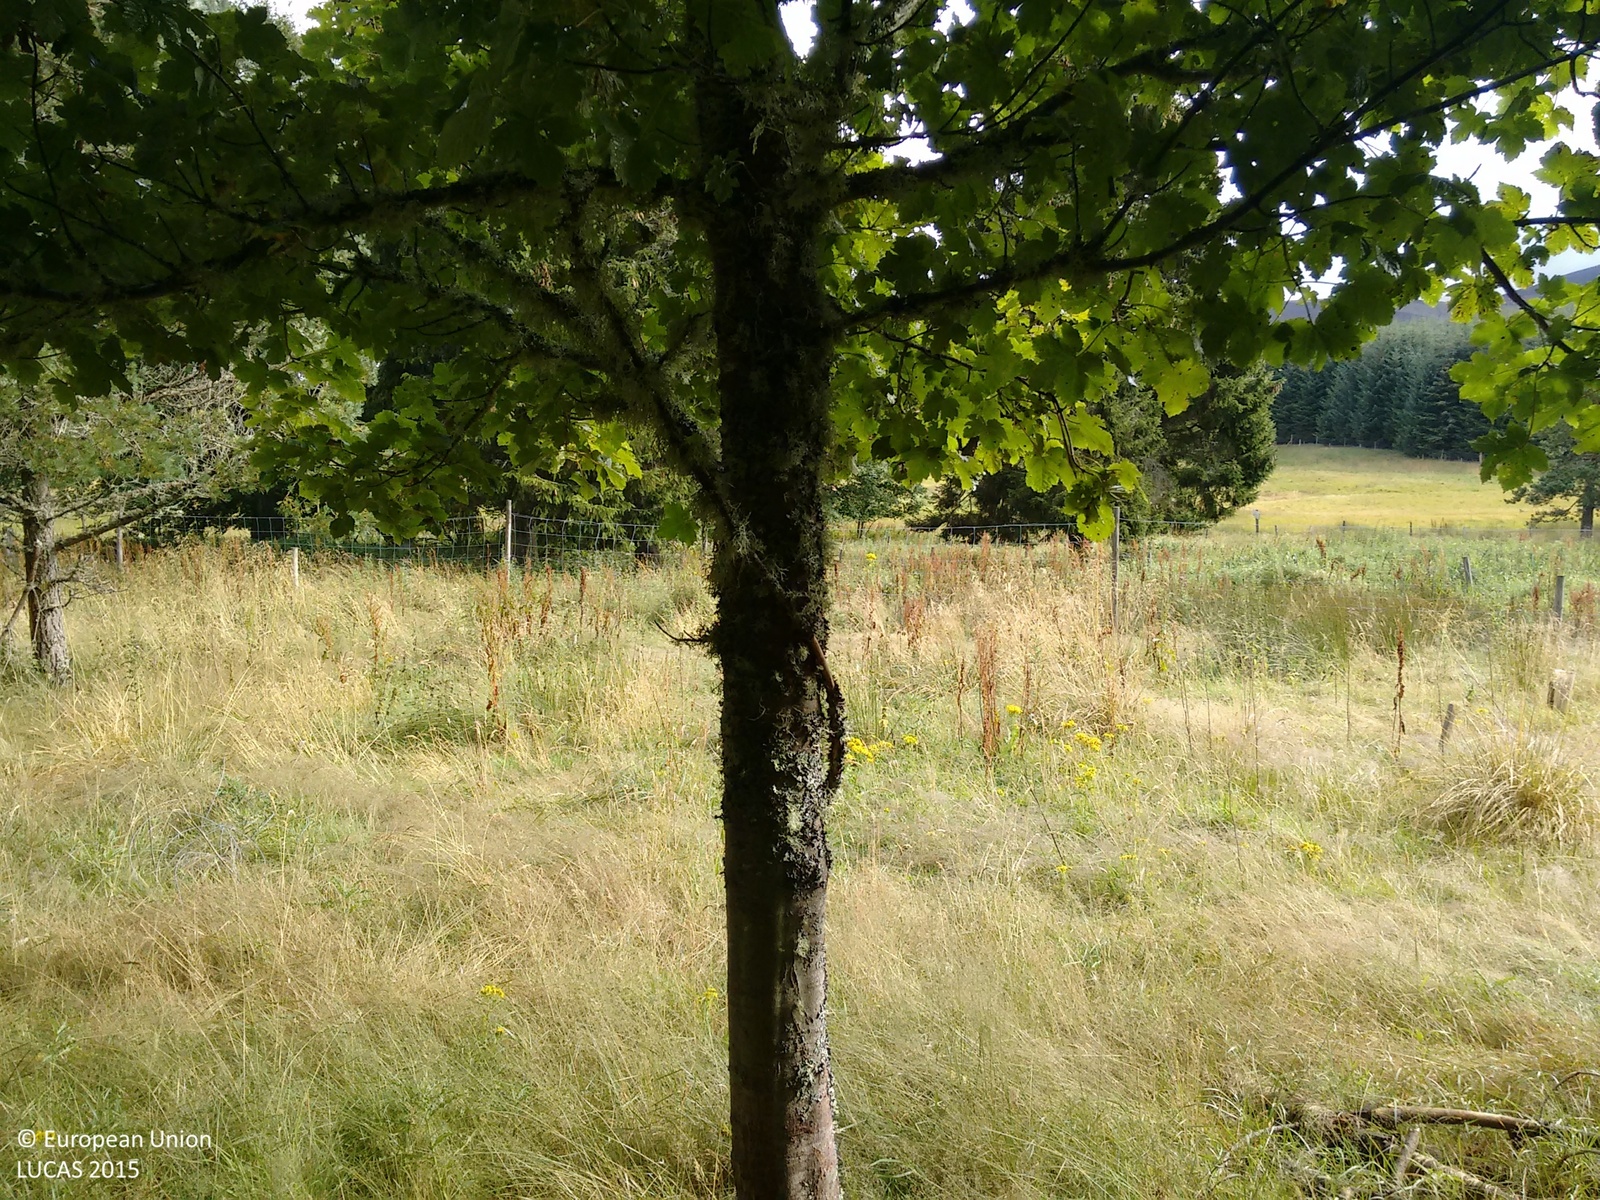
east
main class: Woodland
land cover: Spruce dominated coniferous woodland
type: exotic forest
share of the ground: > 75 %
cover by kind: coniferous forest trees 70 %, herbaceous plants 25 %, broadleaved forest trees 5 %
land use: Forestry
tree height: > 5 m
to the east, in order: Spruce dominated coniferous woodland; Other mixed woodland; Fences; Other mixed woodland; Fences; Grassland without tree/shrub cover; Fences; Grassland with sparse tree/shrub cover
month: September
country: GB
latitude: 57.3588
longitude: -3.2485
